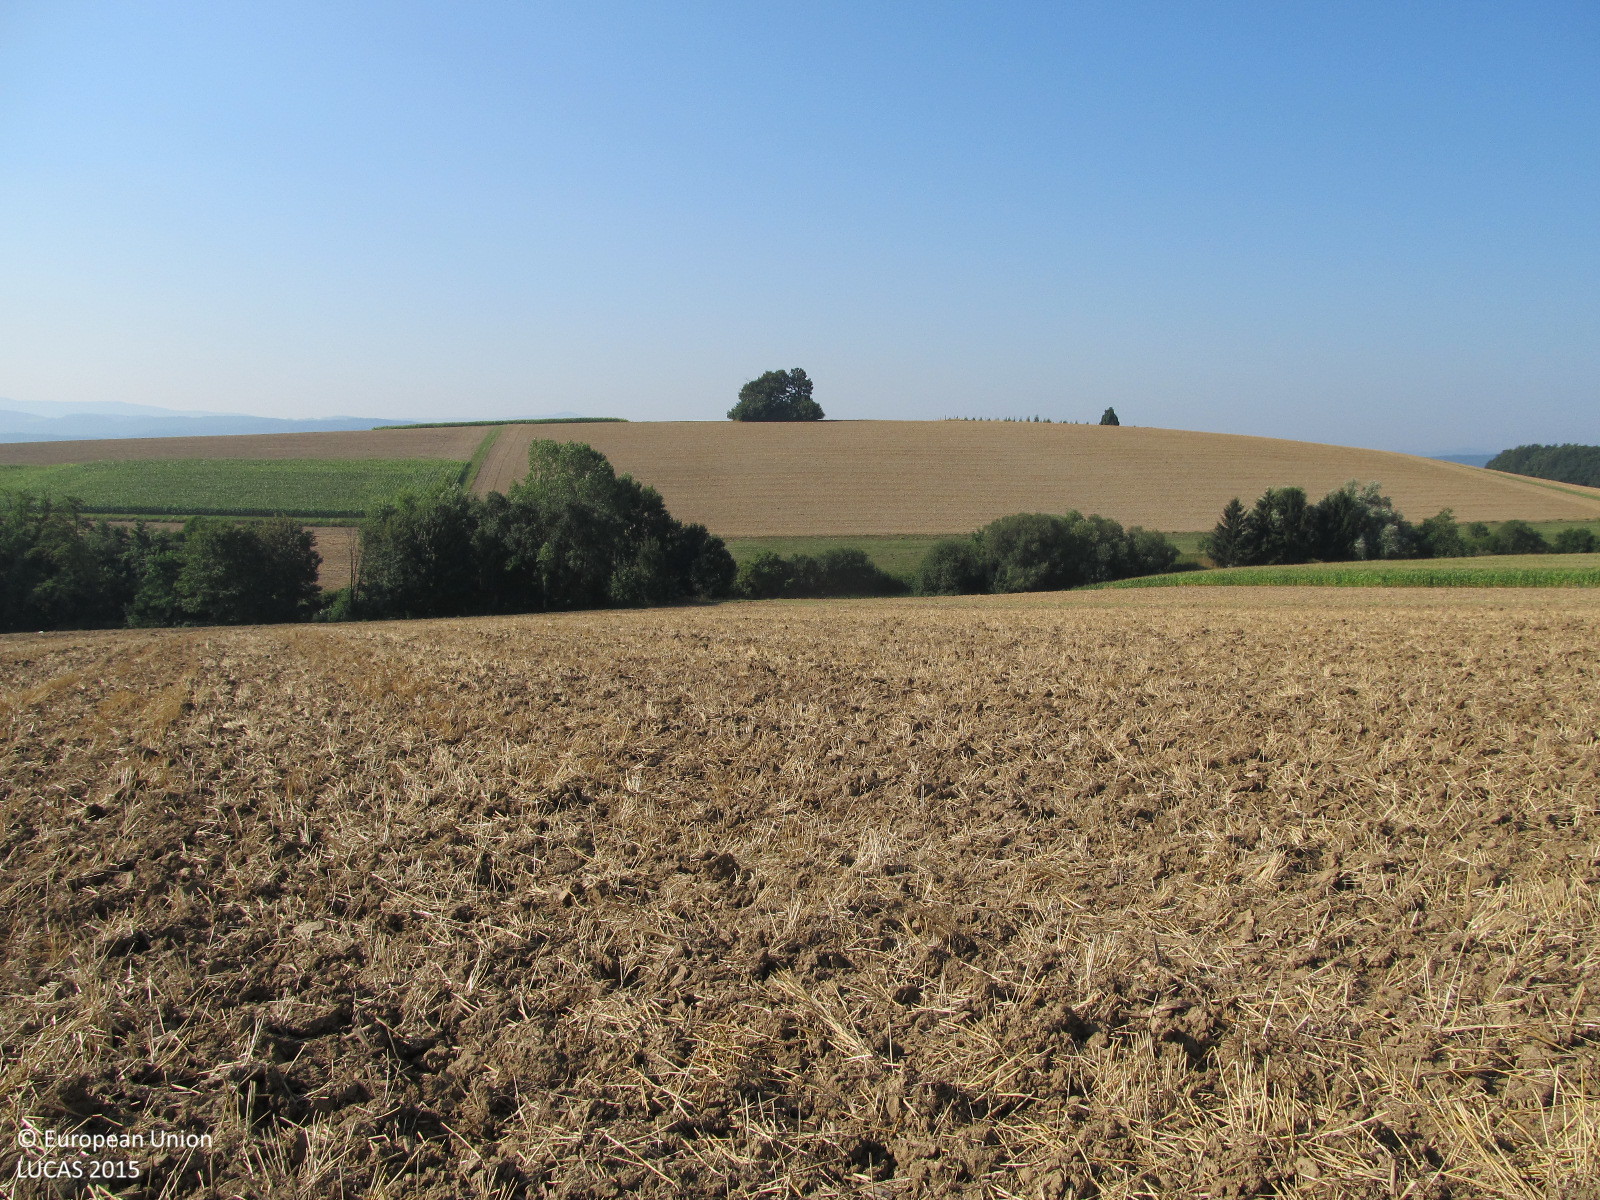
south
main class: Cropland
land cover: Common wheat
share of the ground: 10 - 25 %
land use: Agriculture (excluding fallow land and kitchen gardens)
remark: Harvested field
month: August
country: AT
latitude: 48.2136
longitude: 15.8306
